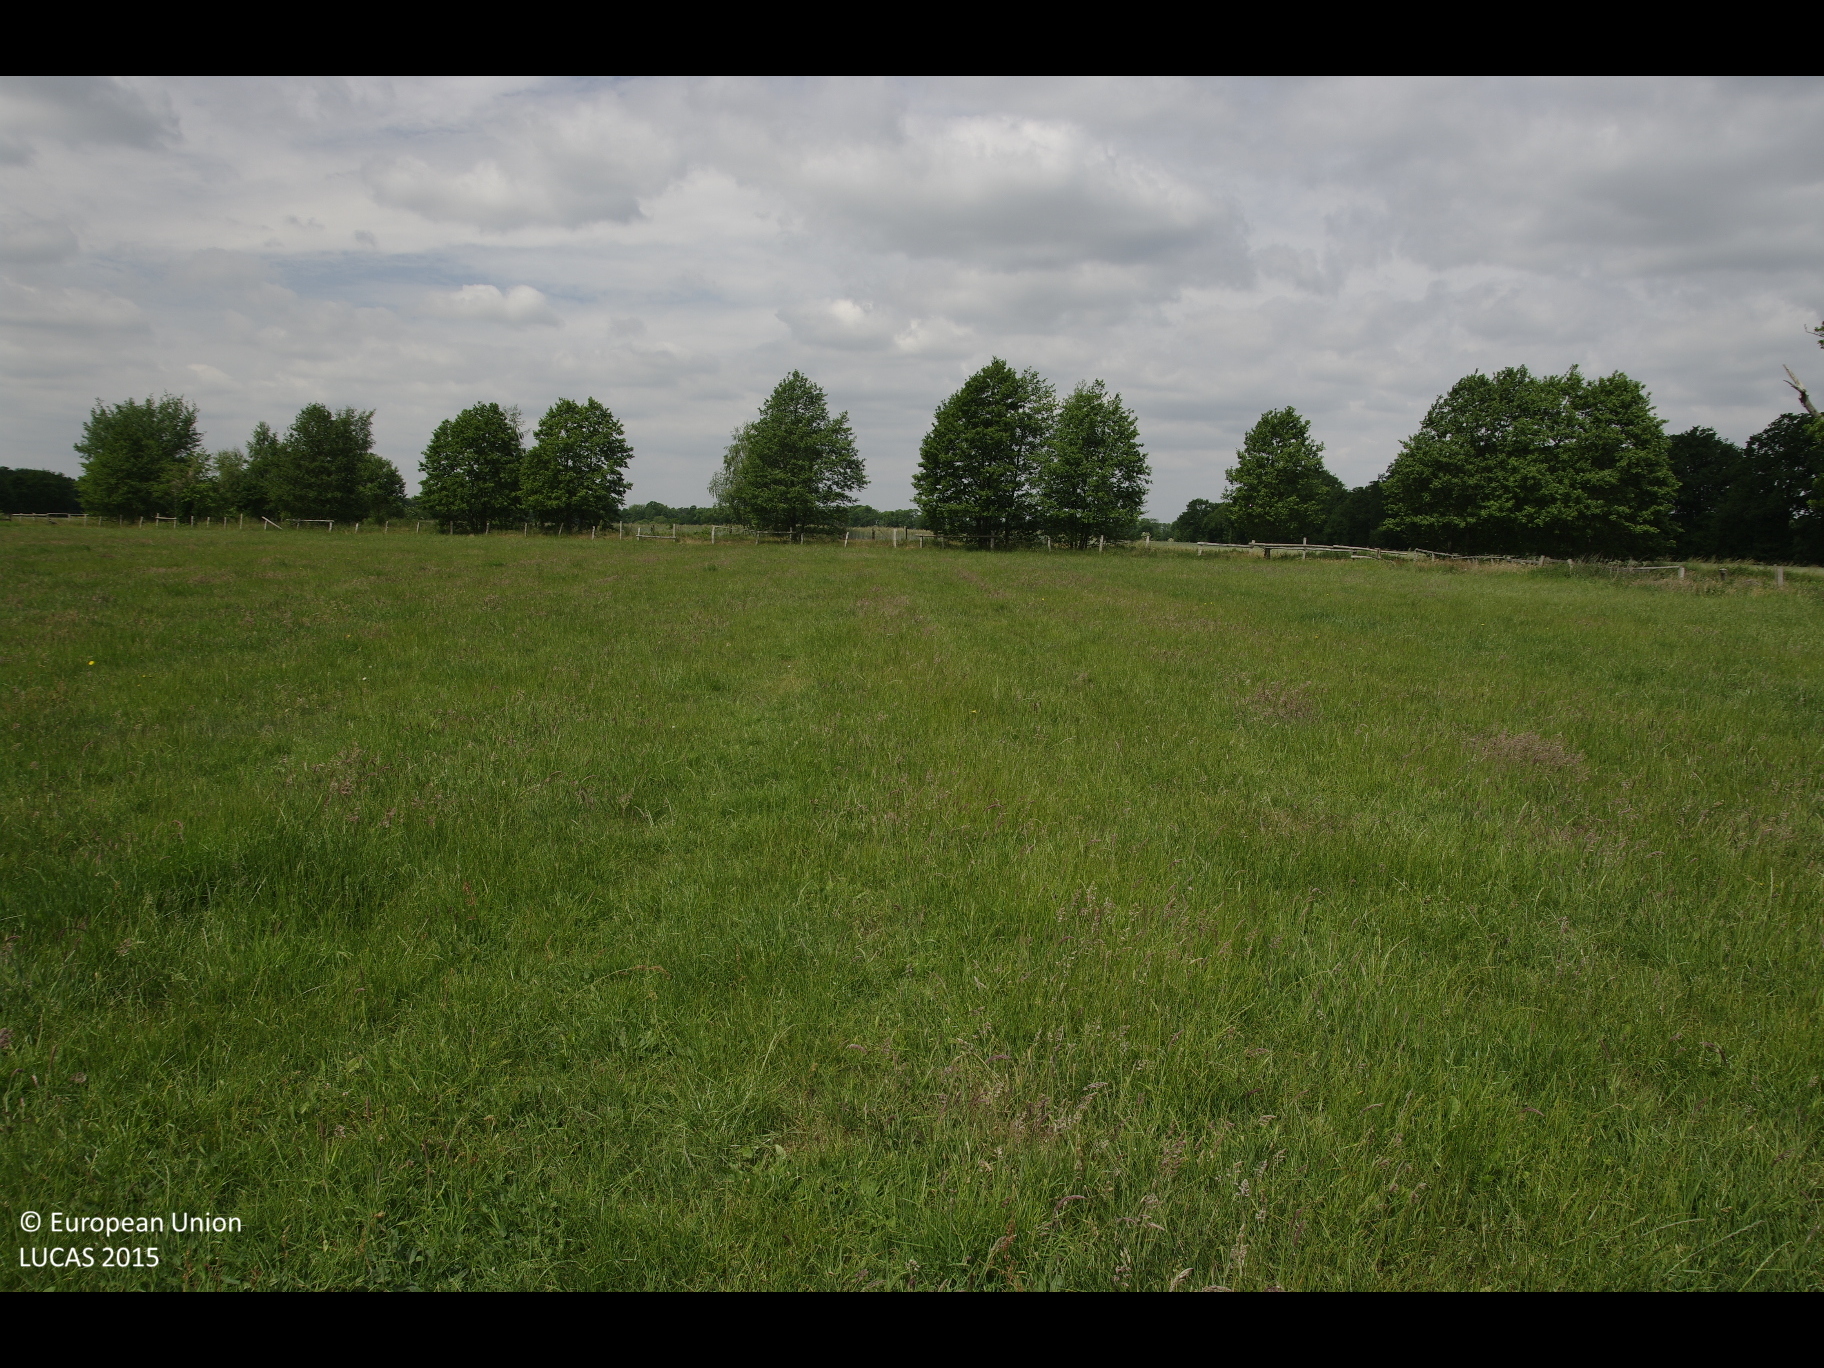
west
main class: Grassland
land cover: Grassland without tree/shrub cover
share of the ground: > 75 %
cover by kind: herbaceous plants 100 %
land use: Agriculture (excluding fallow land and kitchen gardens)
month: June
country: DE
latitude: 53.3296
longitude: 10.3152
